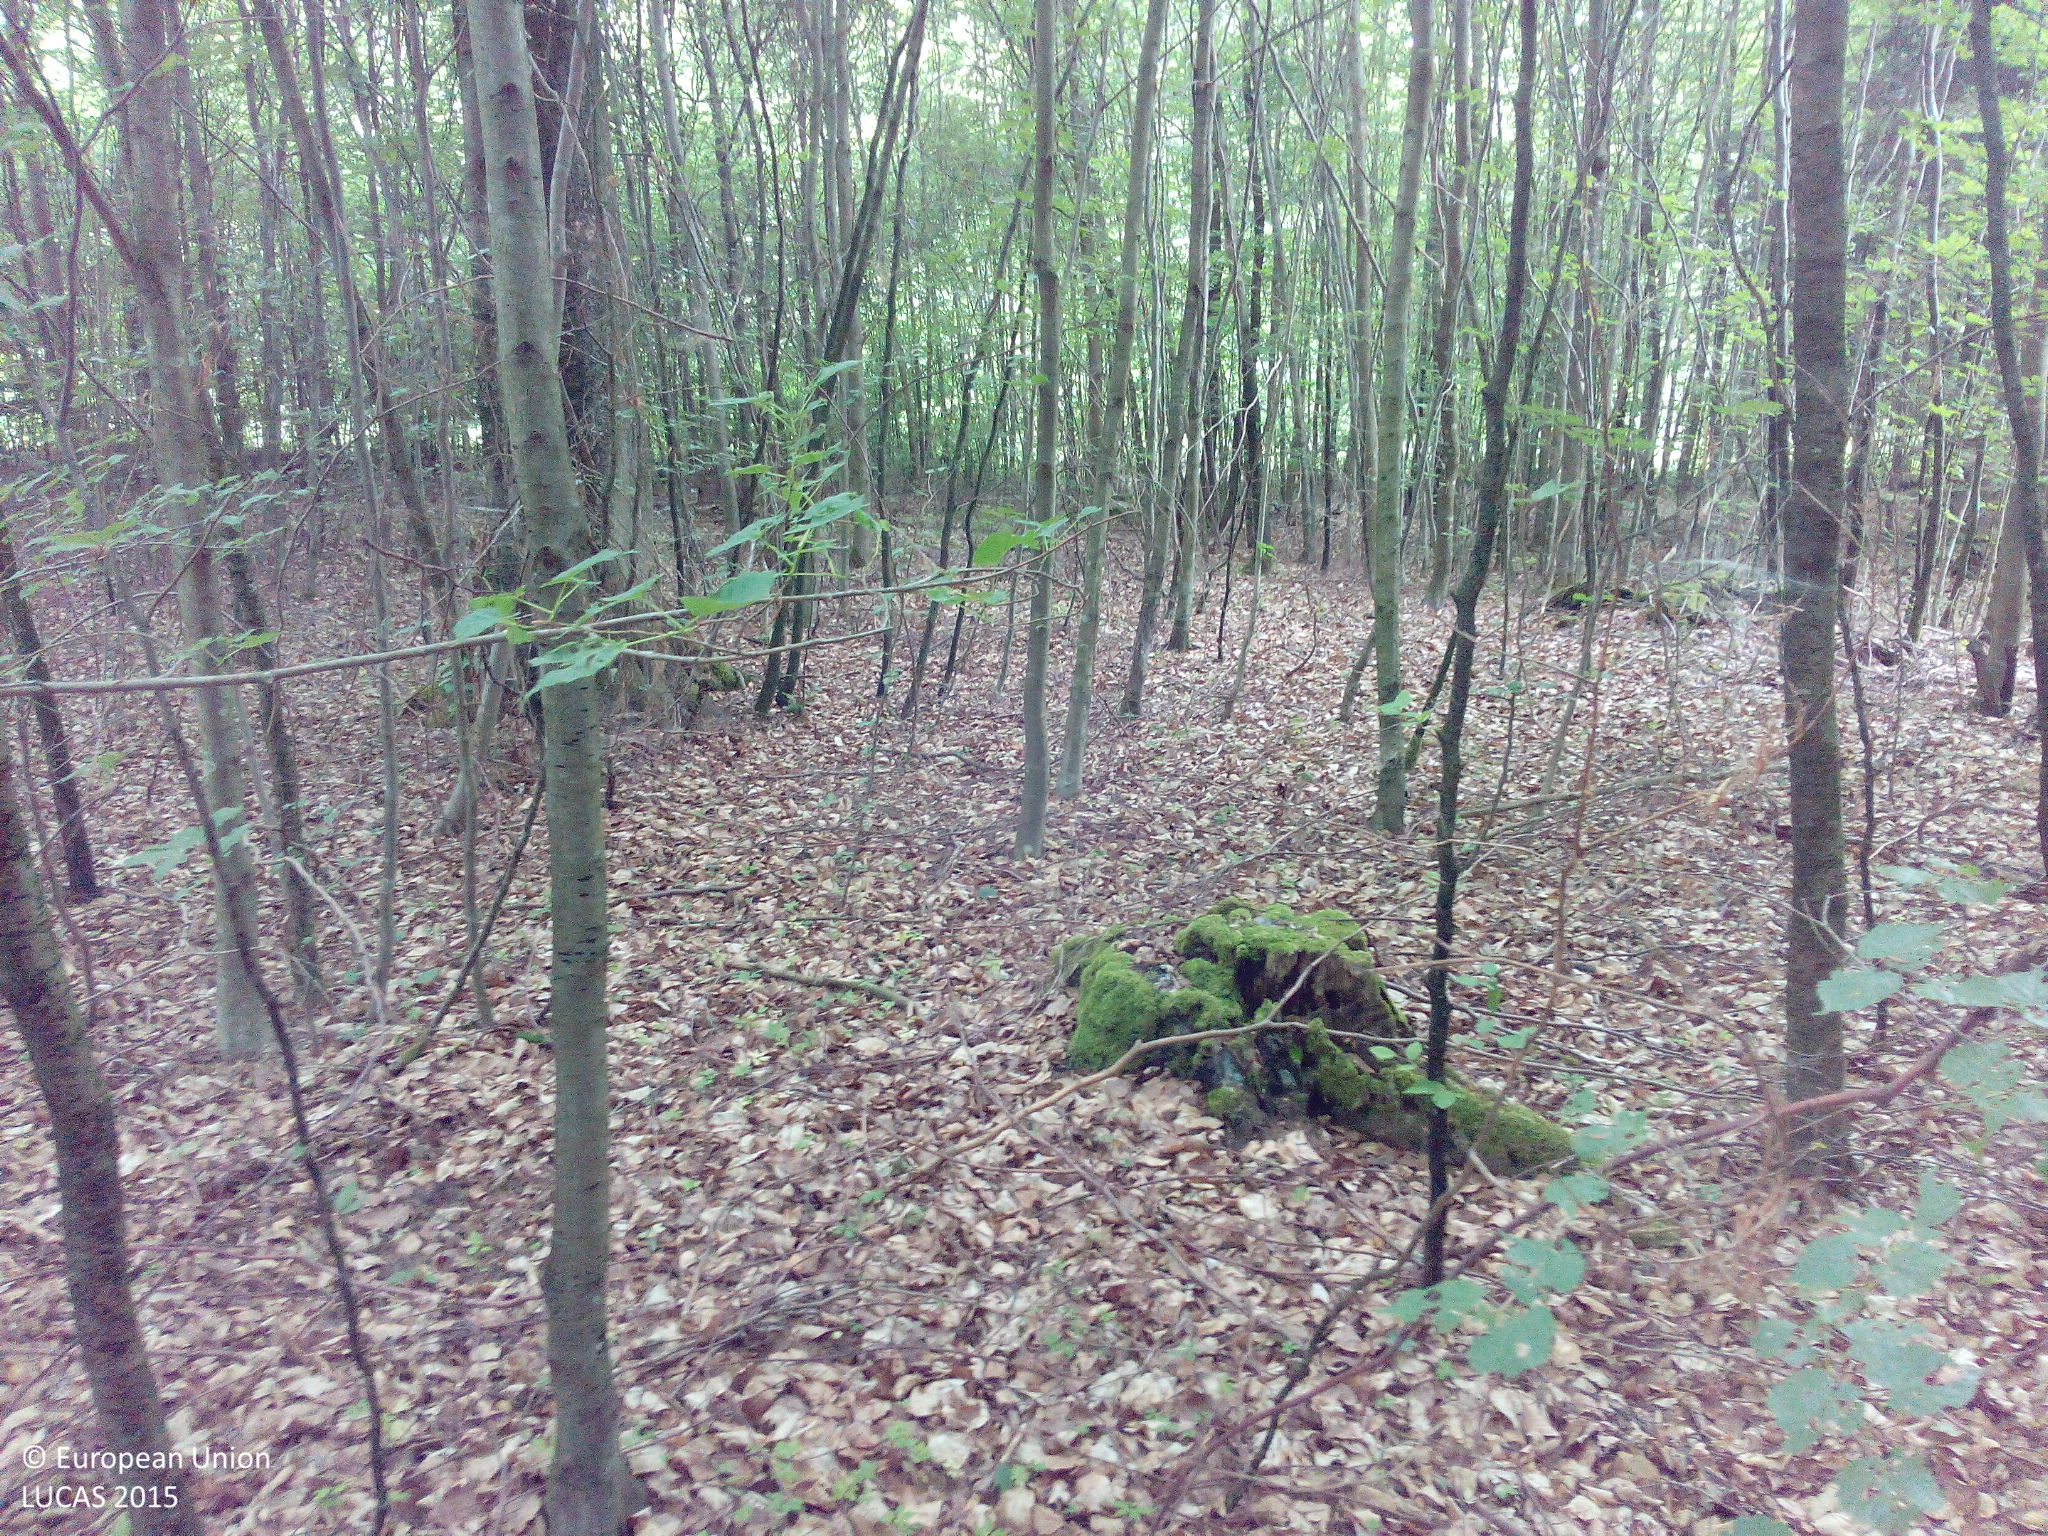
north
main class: Woodland
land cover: Broadleaved woodland
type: mesophytic deciduous forest
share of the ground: > 75 %
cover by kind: broadleaved forest trees 90 %, coniferous forest trees 10 %
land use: Forestry
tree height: > 5 m
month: June
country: DE
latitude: 50.2738
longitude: 10.2665
